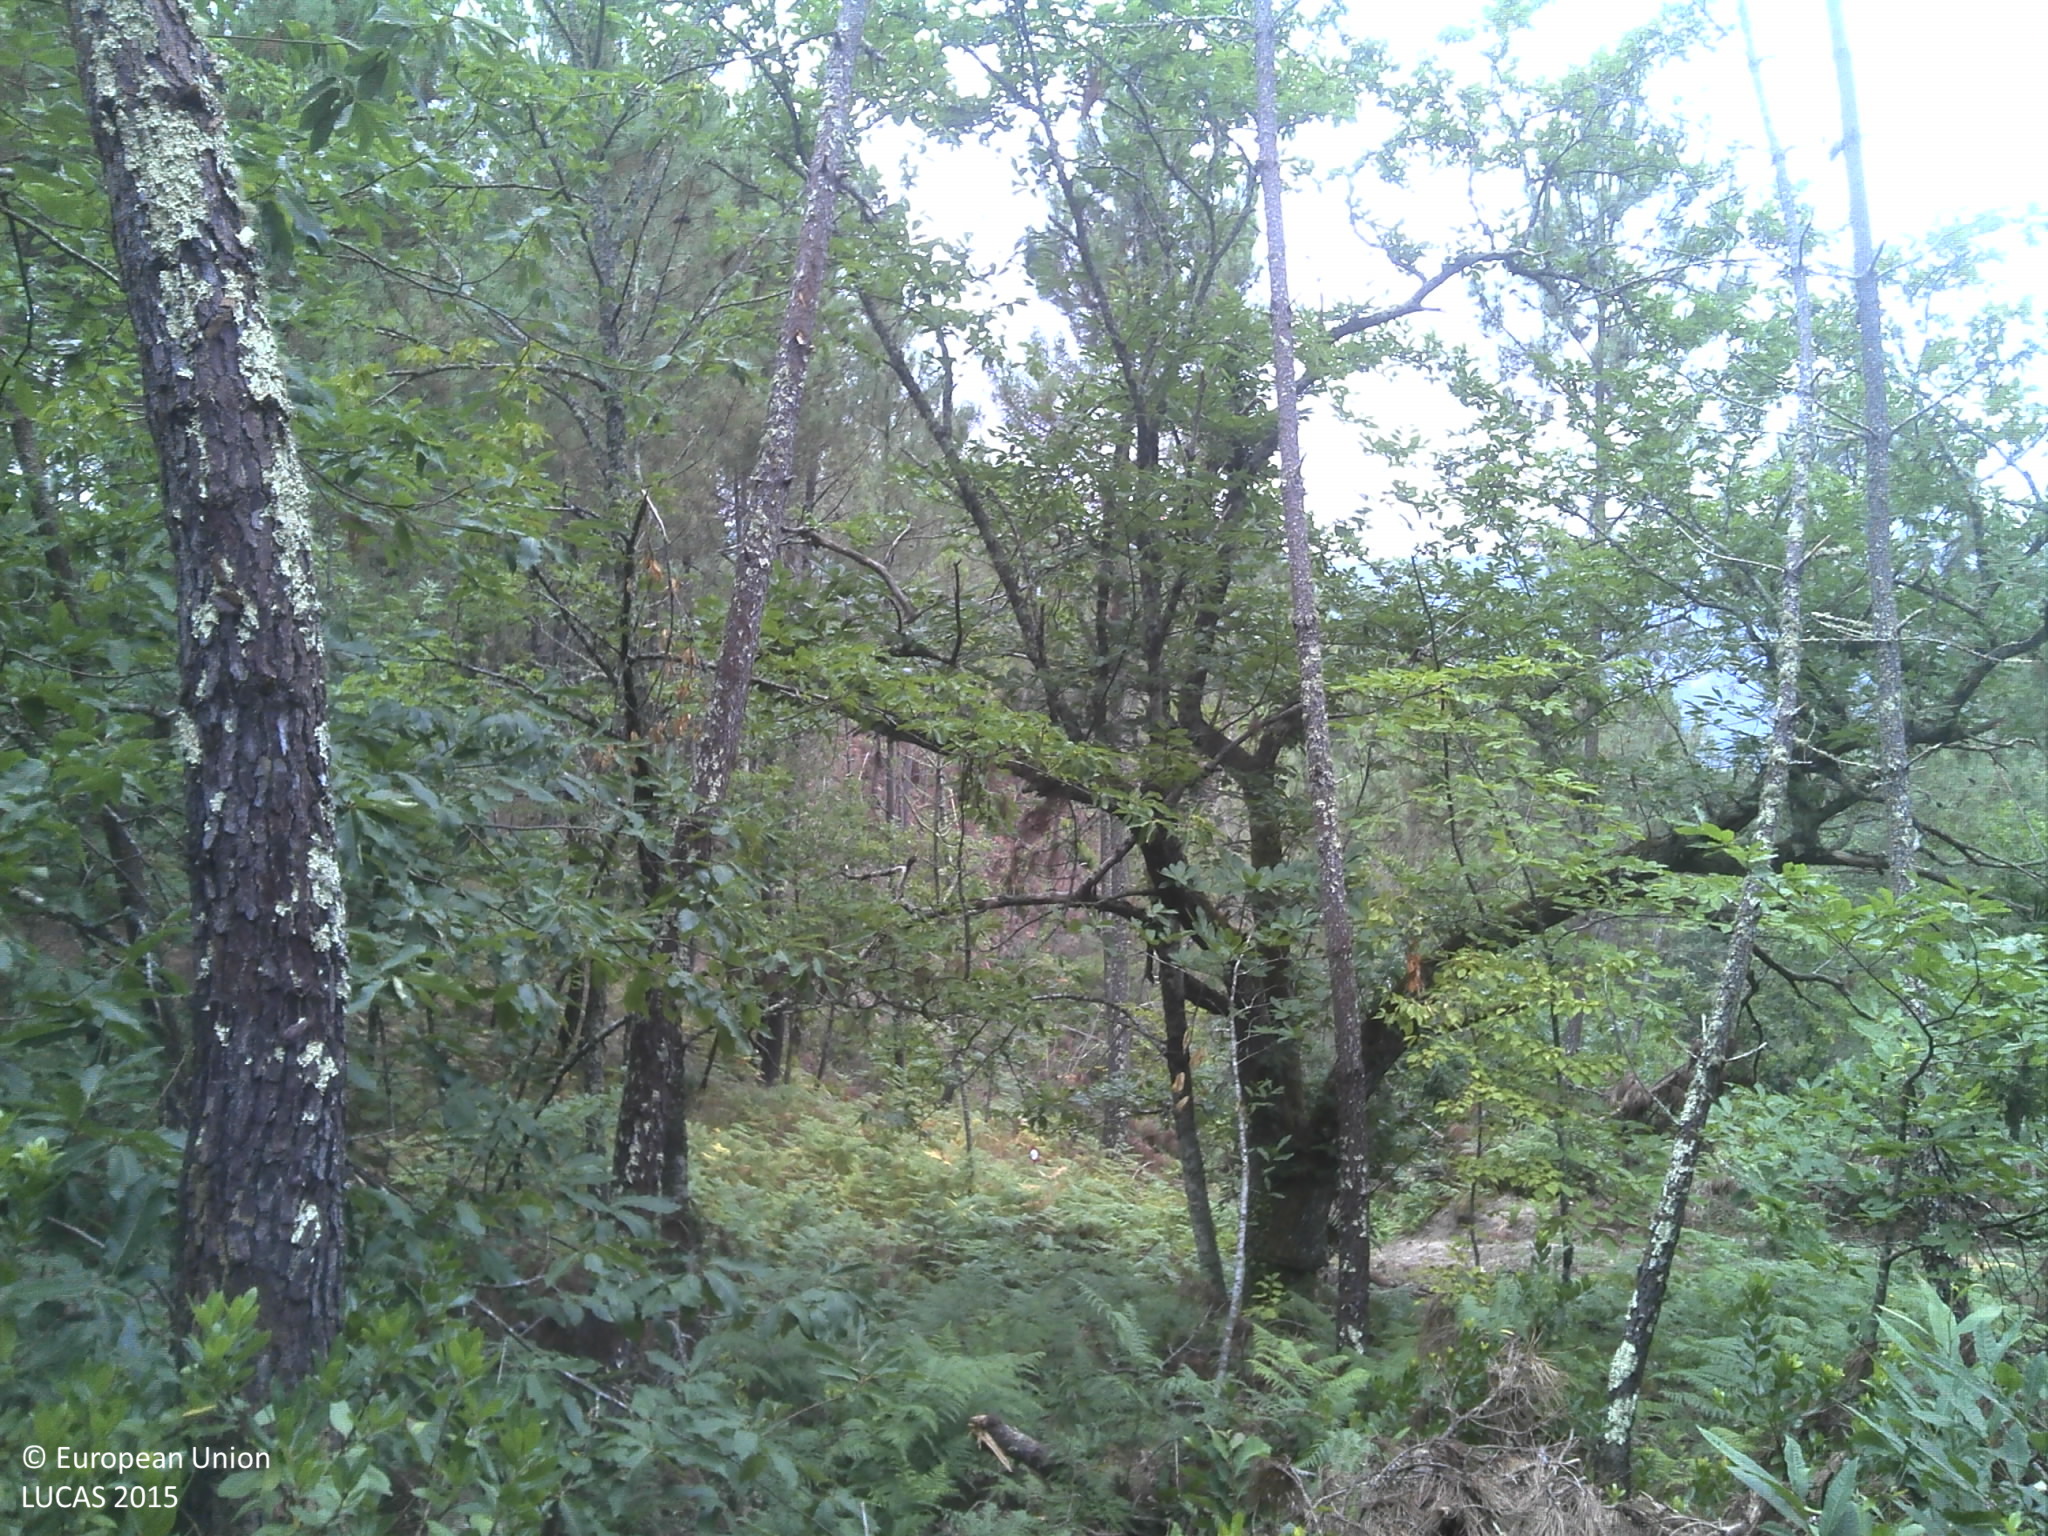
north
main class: Woodland
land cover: Broadleaved woodland
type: thermophilous deciduous forest
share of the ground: 25 - 50 %
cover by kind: broadleaved forest trees 40 %, unconsolidated bare surface 30 %, shrubs 20 %, herbaceous plants 10 %
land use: Forestry
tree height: > 5 m
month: July
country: PT
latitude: 40.3449
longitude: -7.7865
